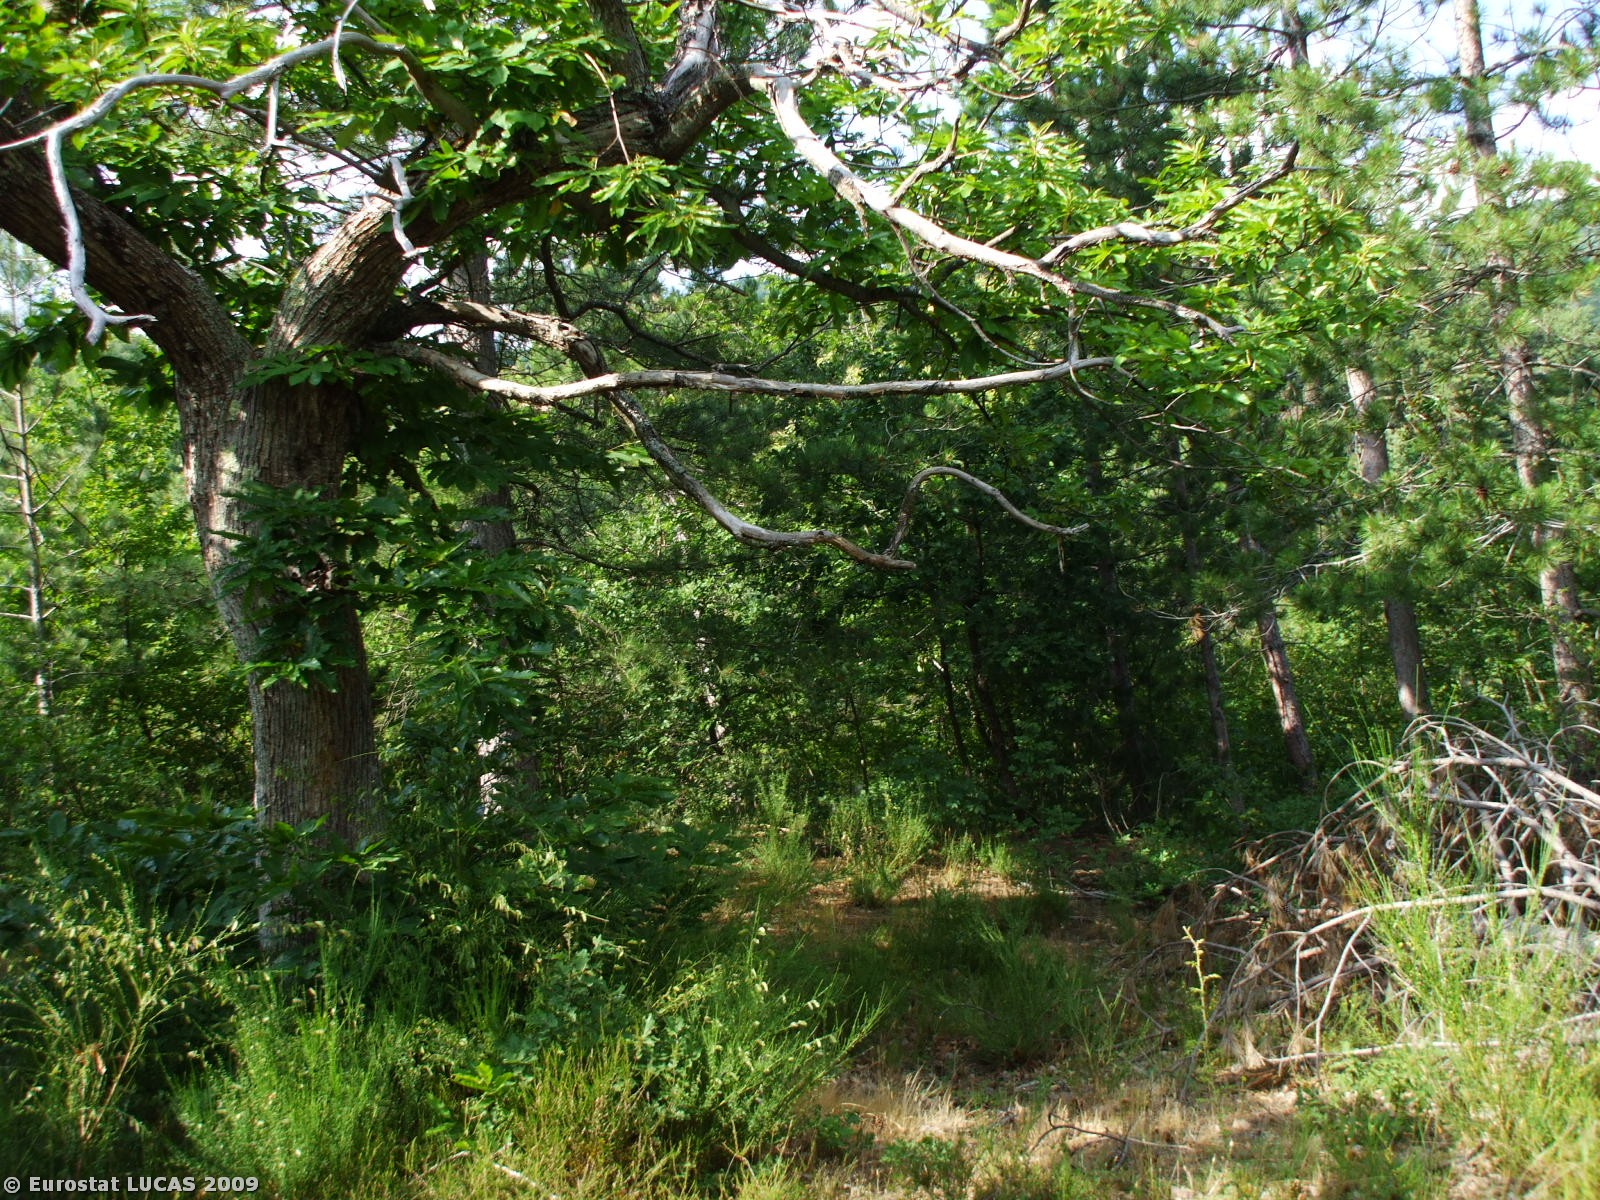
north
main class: Woodland
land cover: Broadleaved woodland
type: thermophilous deciduous forest
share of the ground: > 75 %
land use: Forestry
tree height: > 5 m
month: June
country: IT
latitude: 43.5930
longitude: 11.9148
